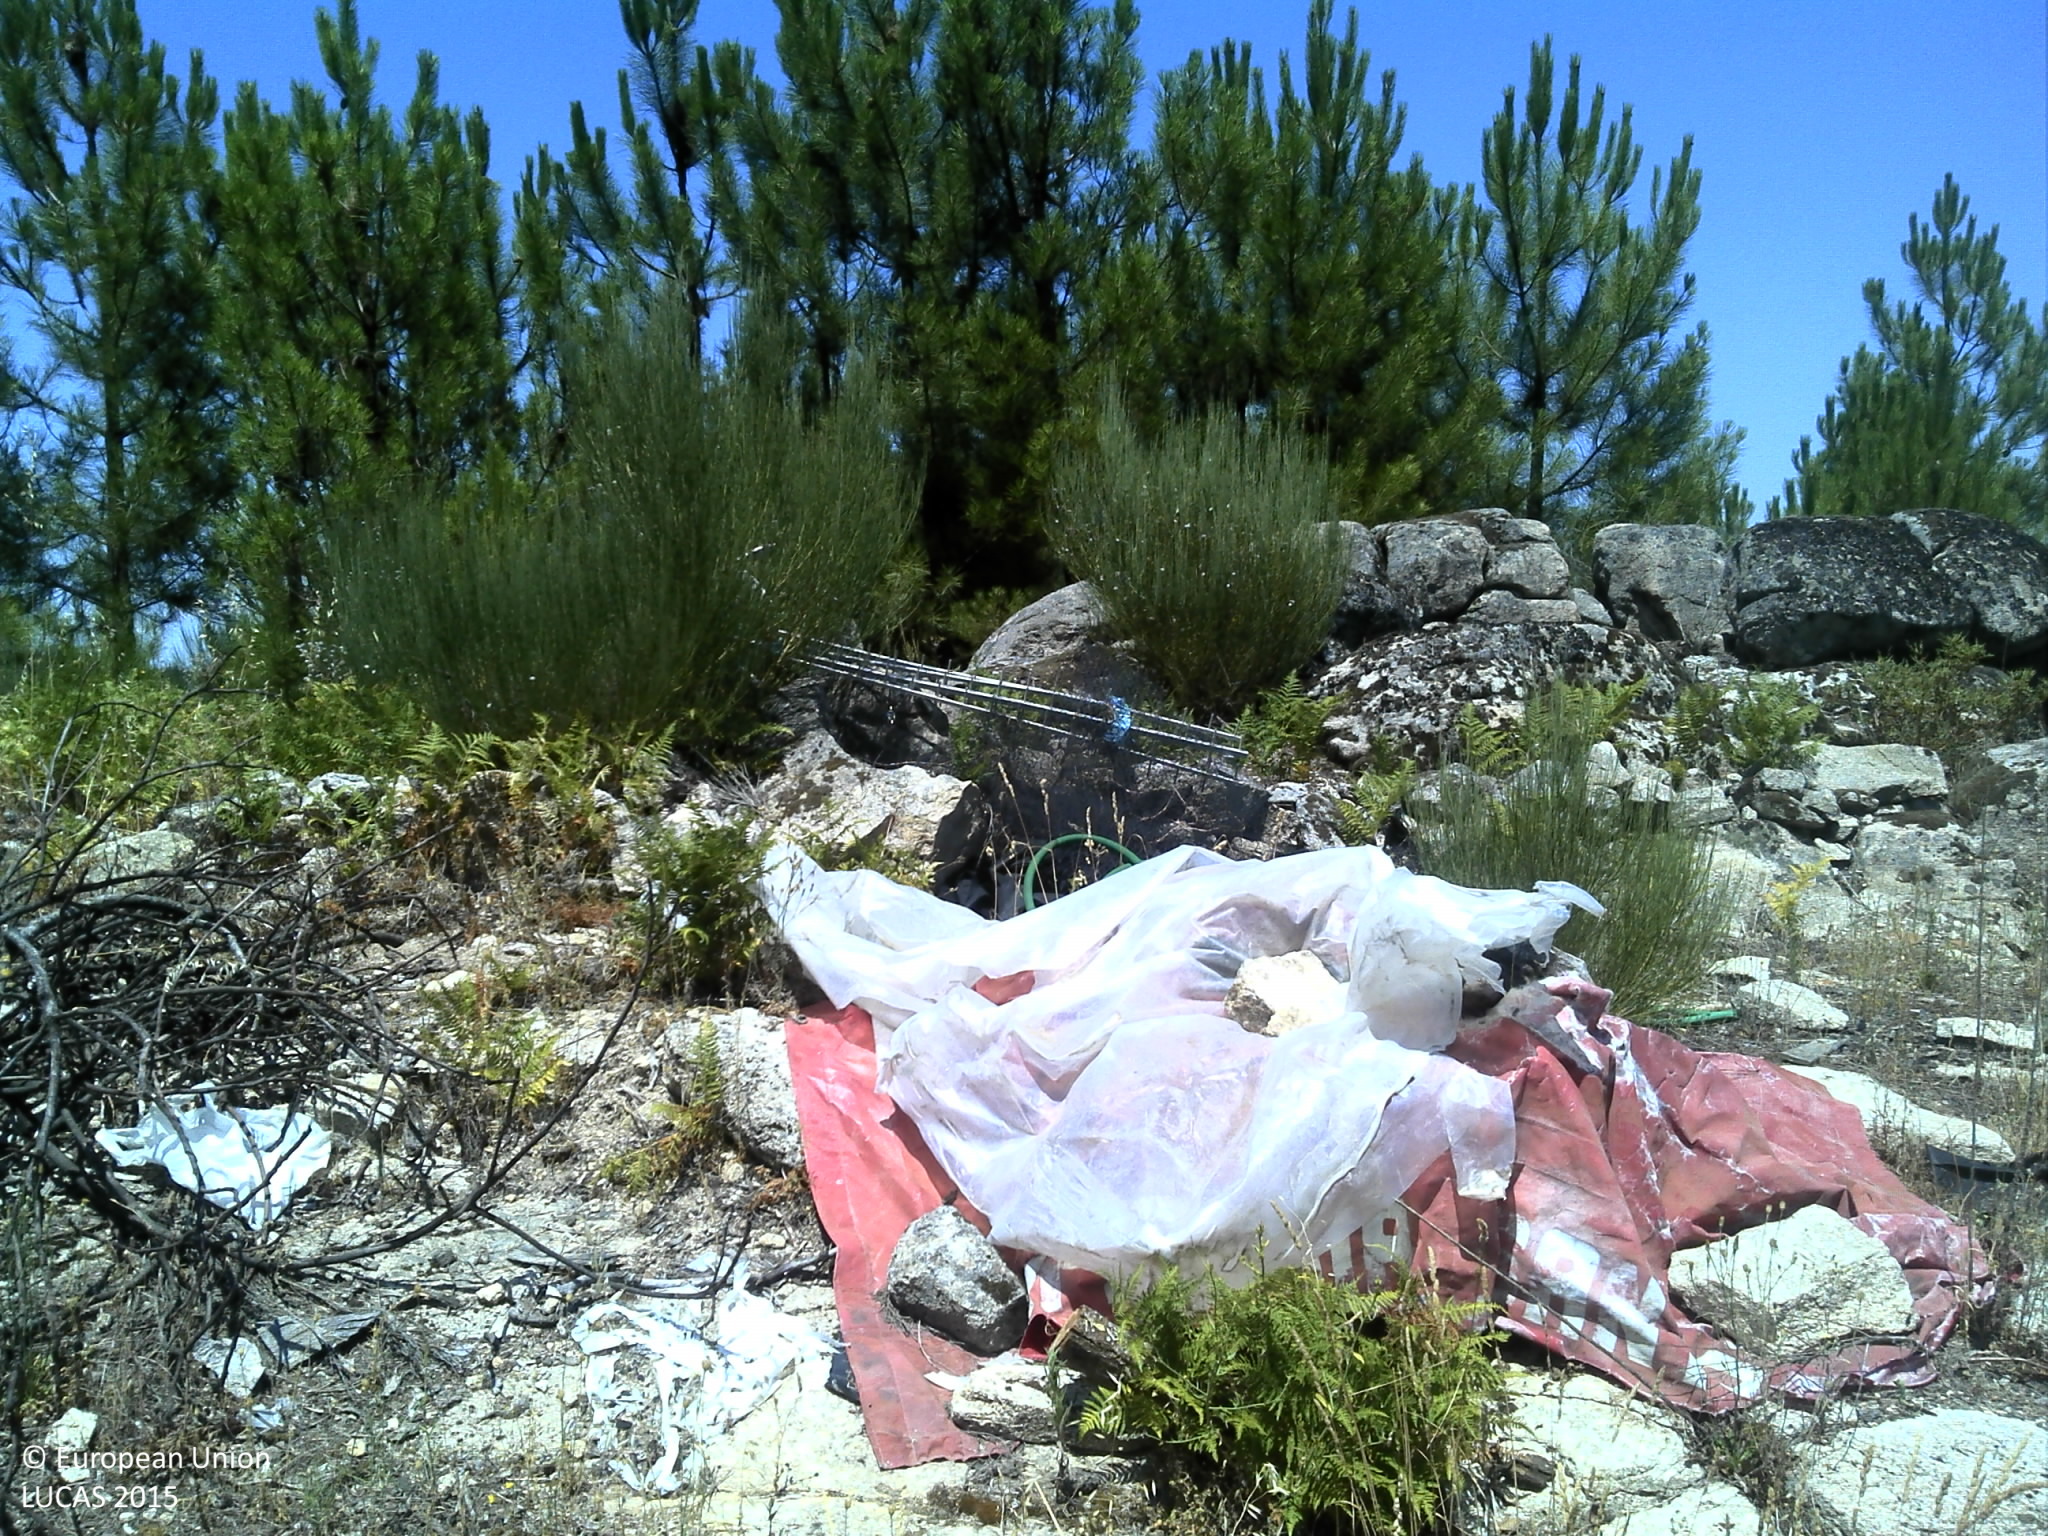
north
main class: Grassland
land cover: Grassland with sparse tree/shrub cover
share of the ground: 50 - 75 %
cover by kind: herbaceous plants 40 %, consolidated bare surface 20 %, unconsolidated bare surface 15 %, shrubs 10 %, coniferous forest trees 5 %
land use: Abandoned areas
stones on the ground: 25 - 50 %
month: July
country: PT
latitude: 41.5552
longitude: -7.6243
